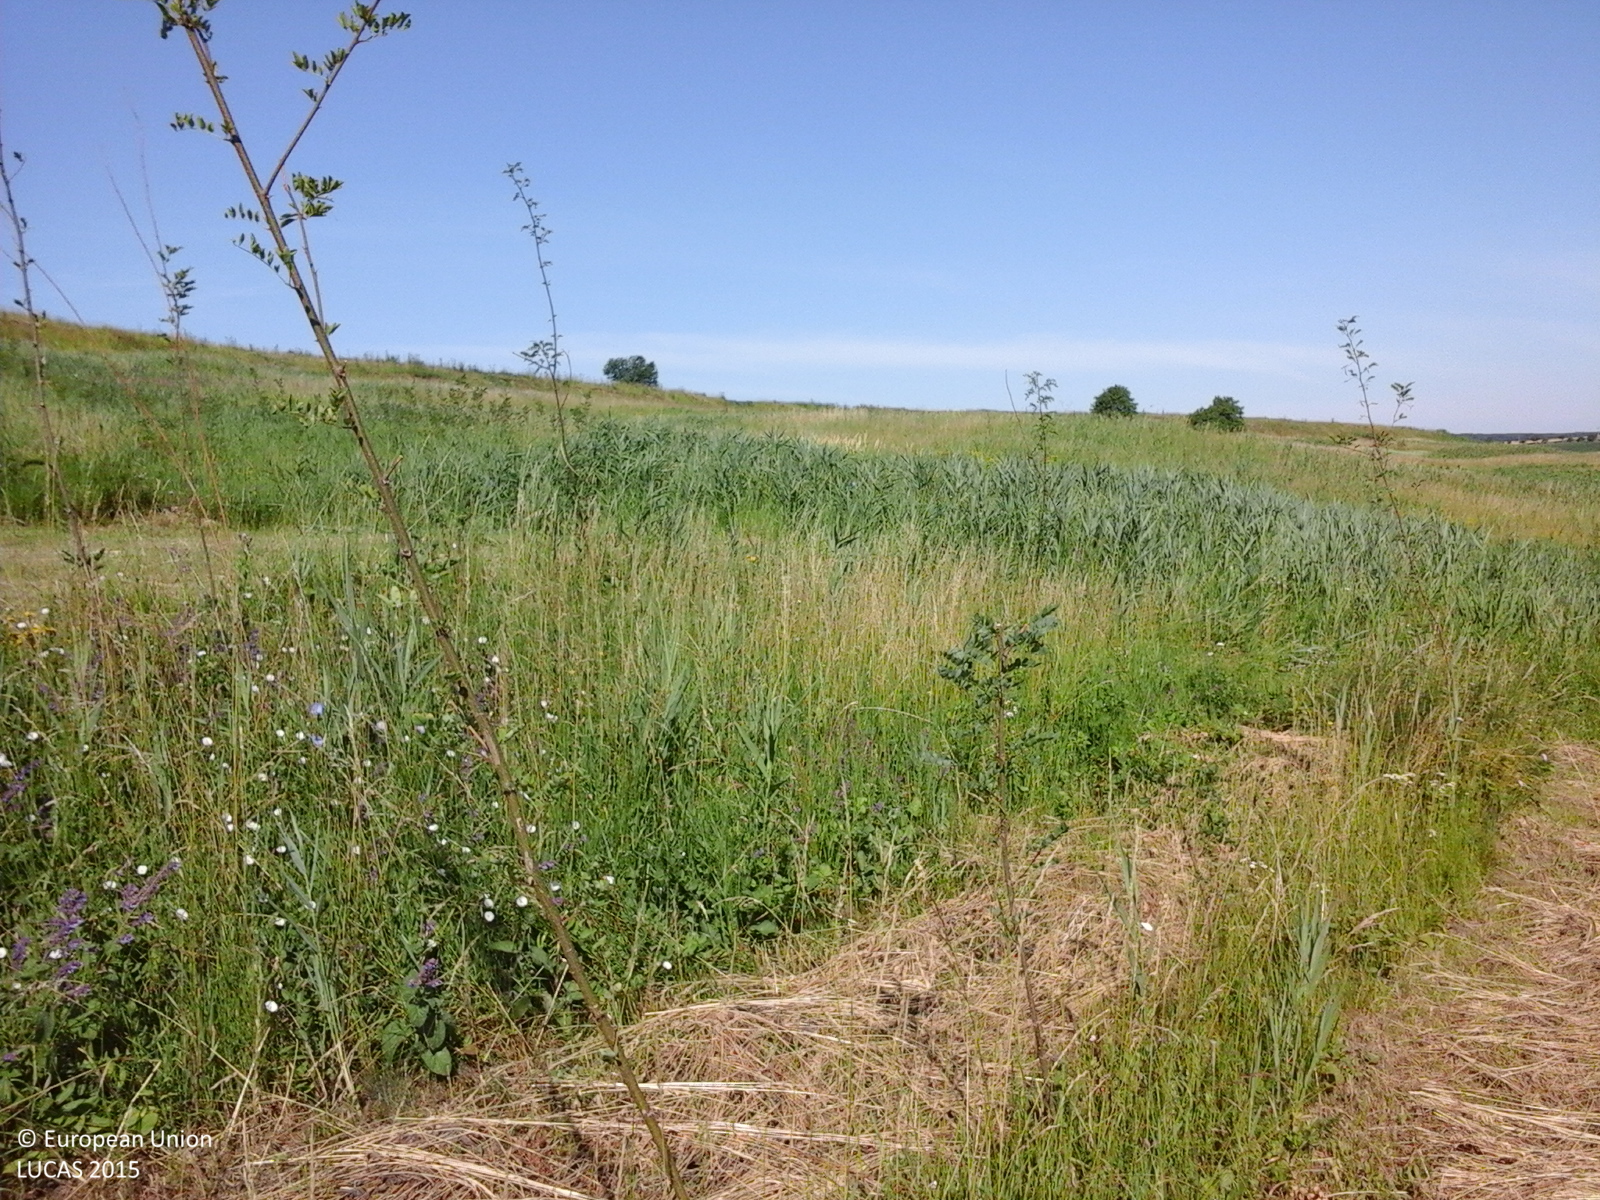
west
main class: Cropland
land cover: Nurseries
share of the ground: > 75 %
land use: Forestry
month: June
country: RO
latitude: 47.9926
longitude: 27.0048
